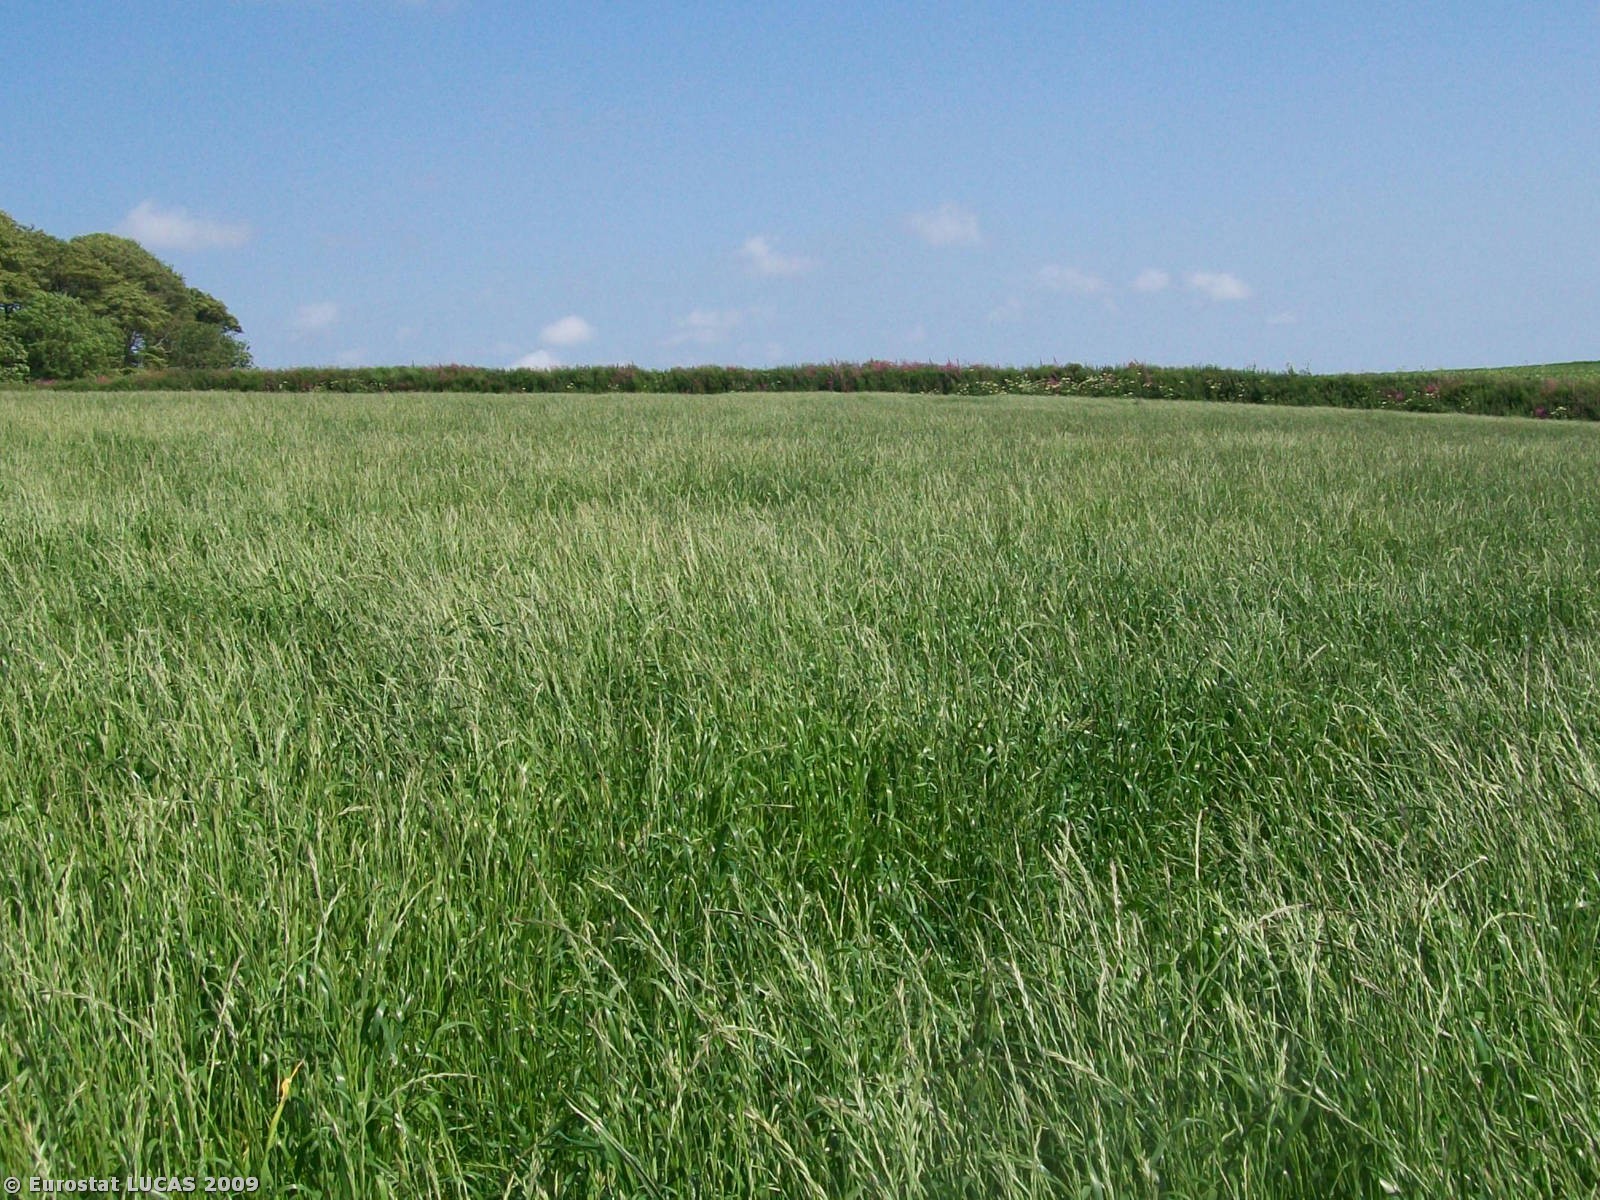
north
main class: Cropland
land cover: Temporary grasslands
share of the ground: > 75 %
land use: Agriculture (excluding fallow land and kitchen gardens)
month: June
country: GB
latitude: 50.1652
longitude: -5.0539
